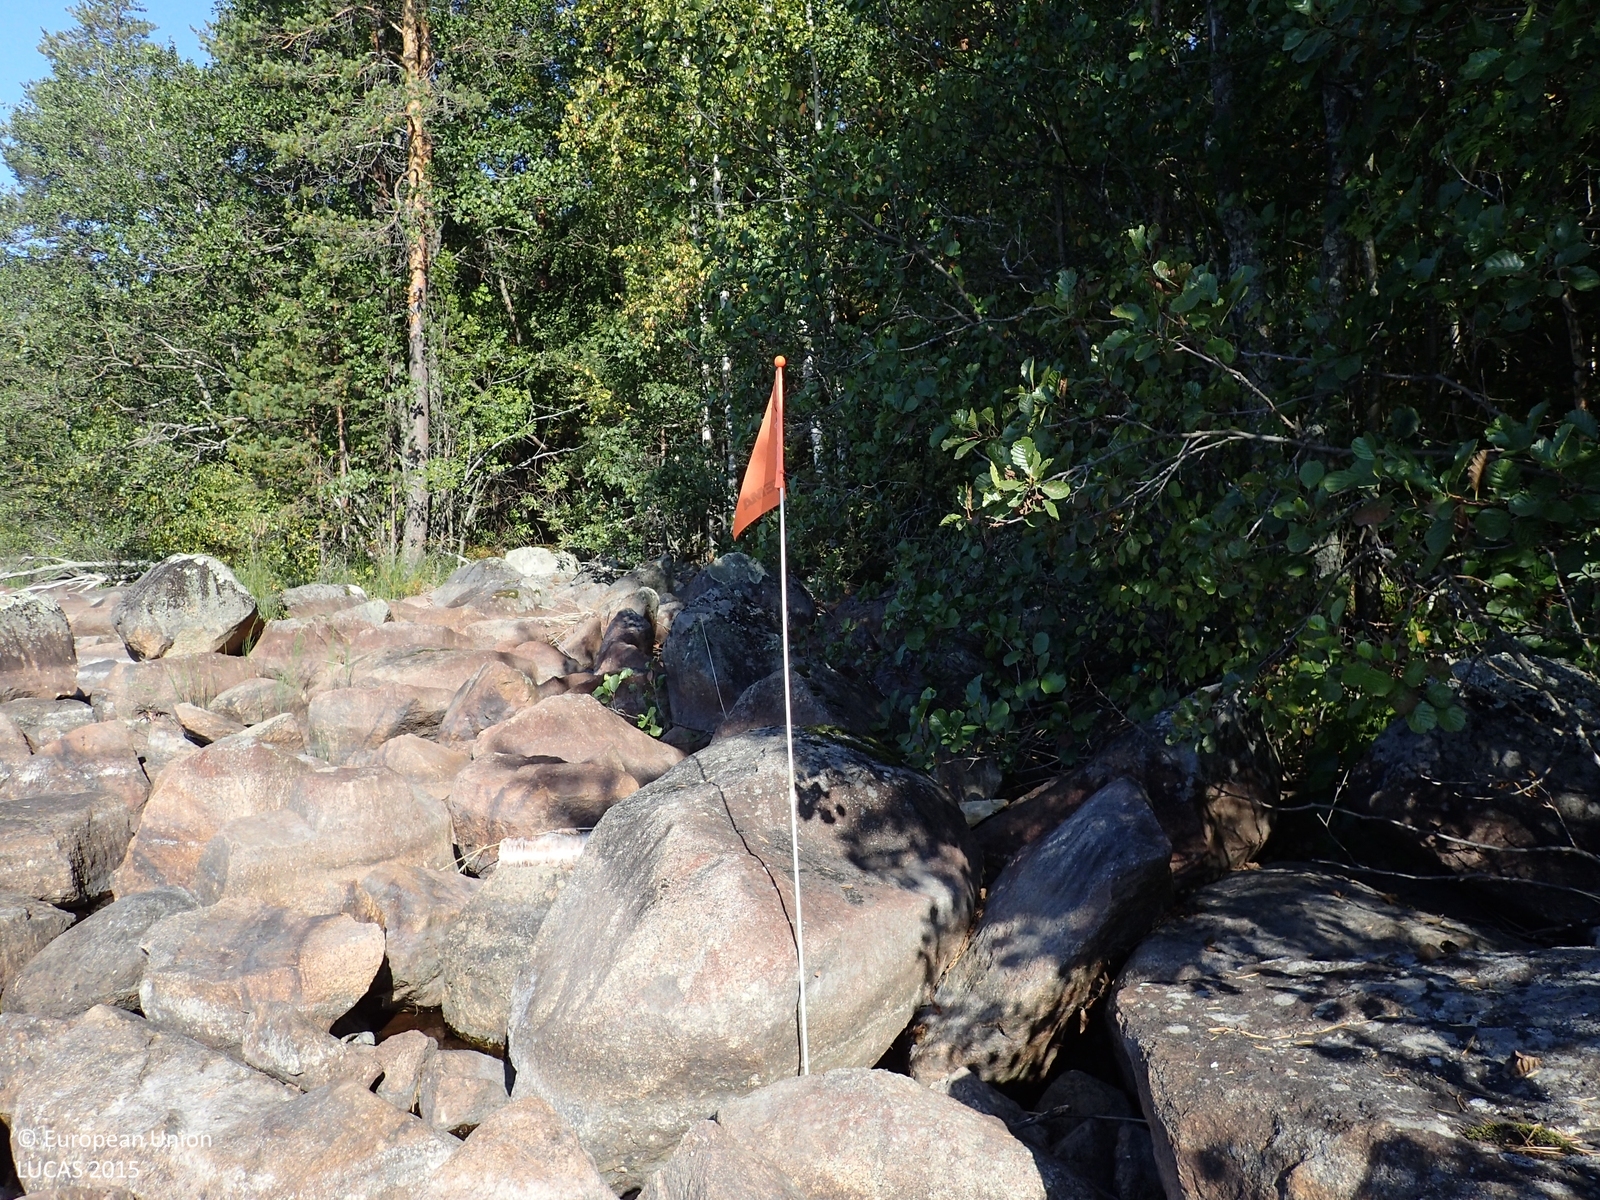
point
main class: Woodland
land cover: Broadleaved woodland
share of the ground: > 75 %
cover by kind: broadleaved forest trees 80 %, coniferous forest trees 10 %, shrubs 10 %
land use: Semi-natural and natural areas not in use
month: September
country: FI
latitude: 63.1394
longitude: 25.2358
